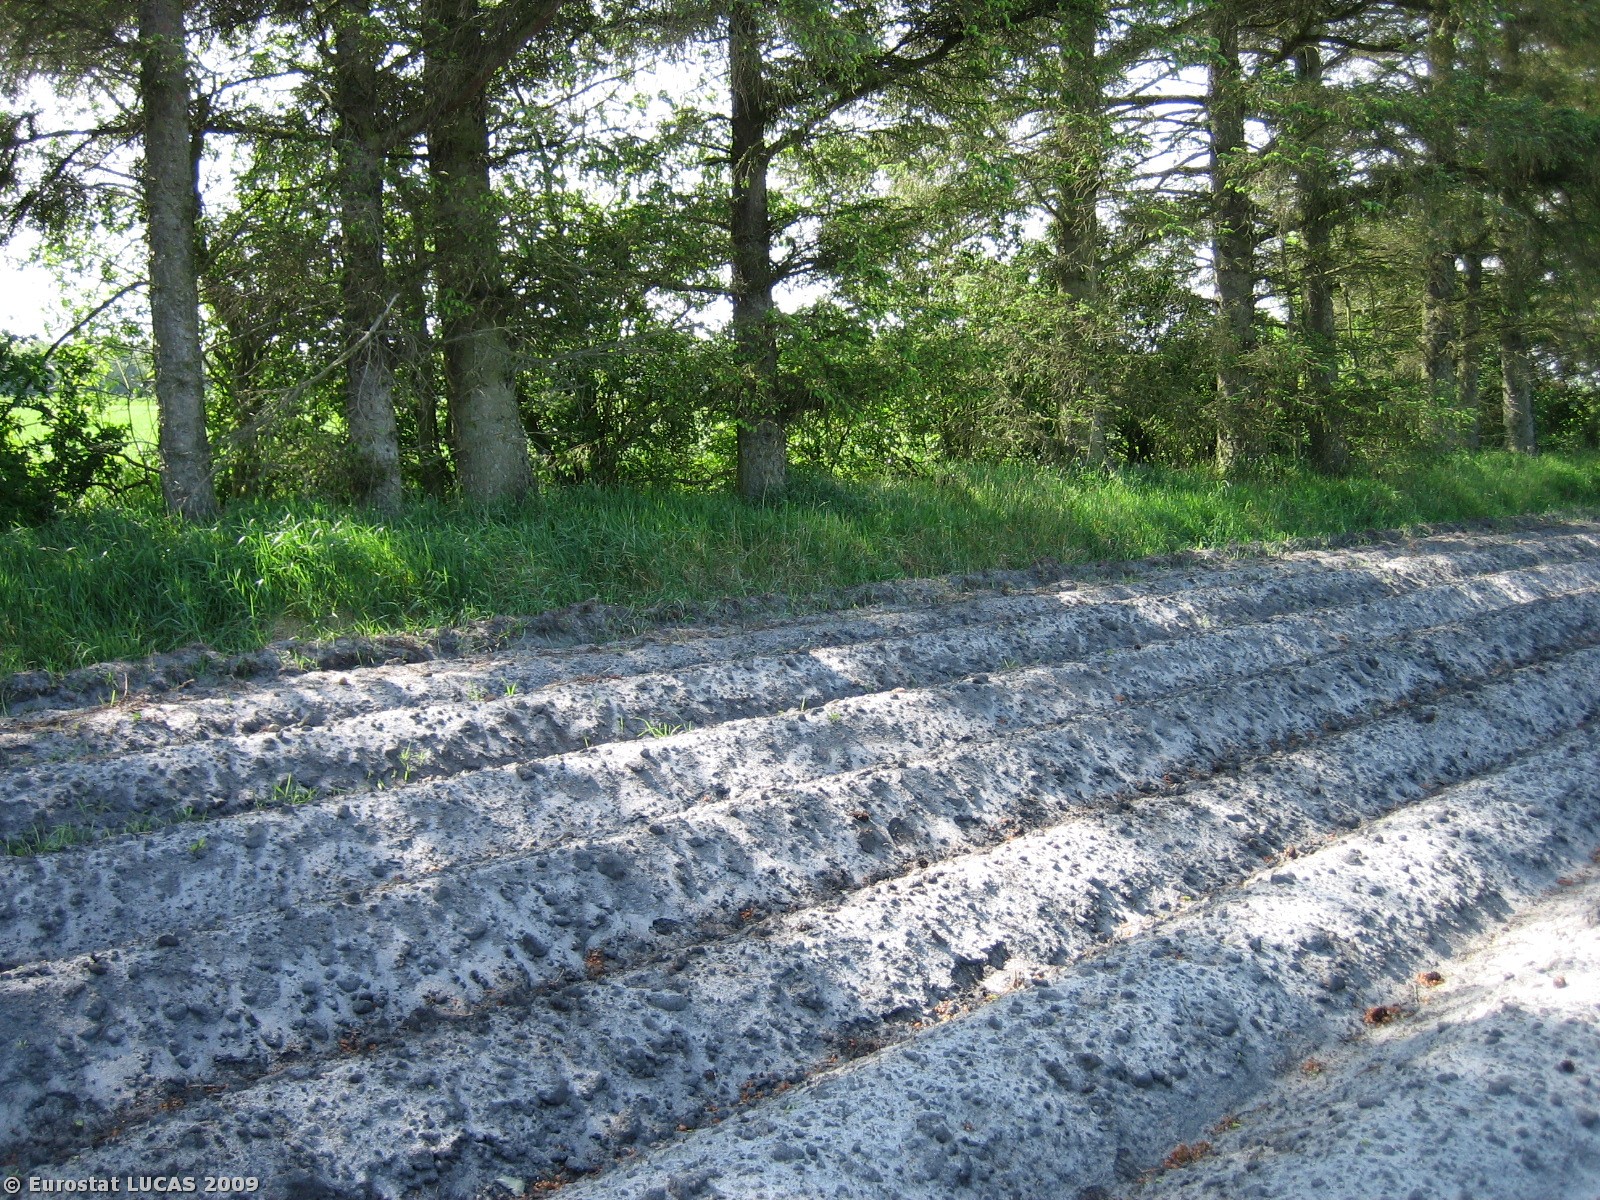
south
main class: Cropland
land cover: Potatoes
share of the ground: < 10 %
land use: Agriculture (excluding fallow land and kitchen gardens)
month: May
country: DK
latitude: 56.1851
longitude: 9.1793
